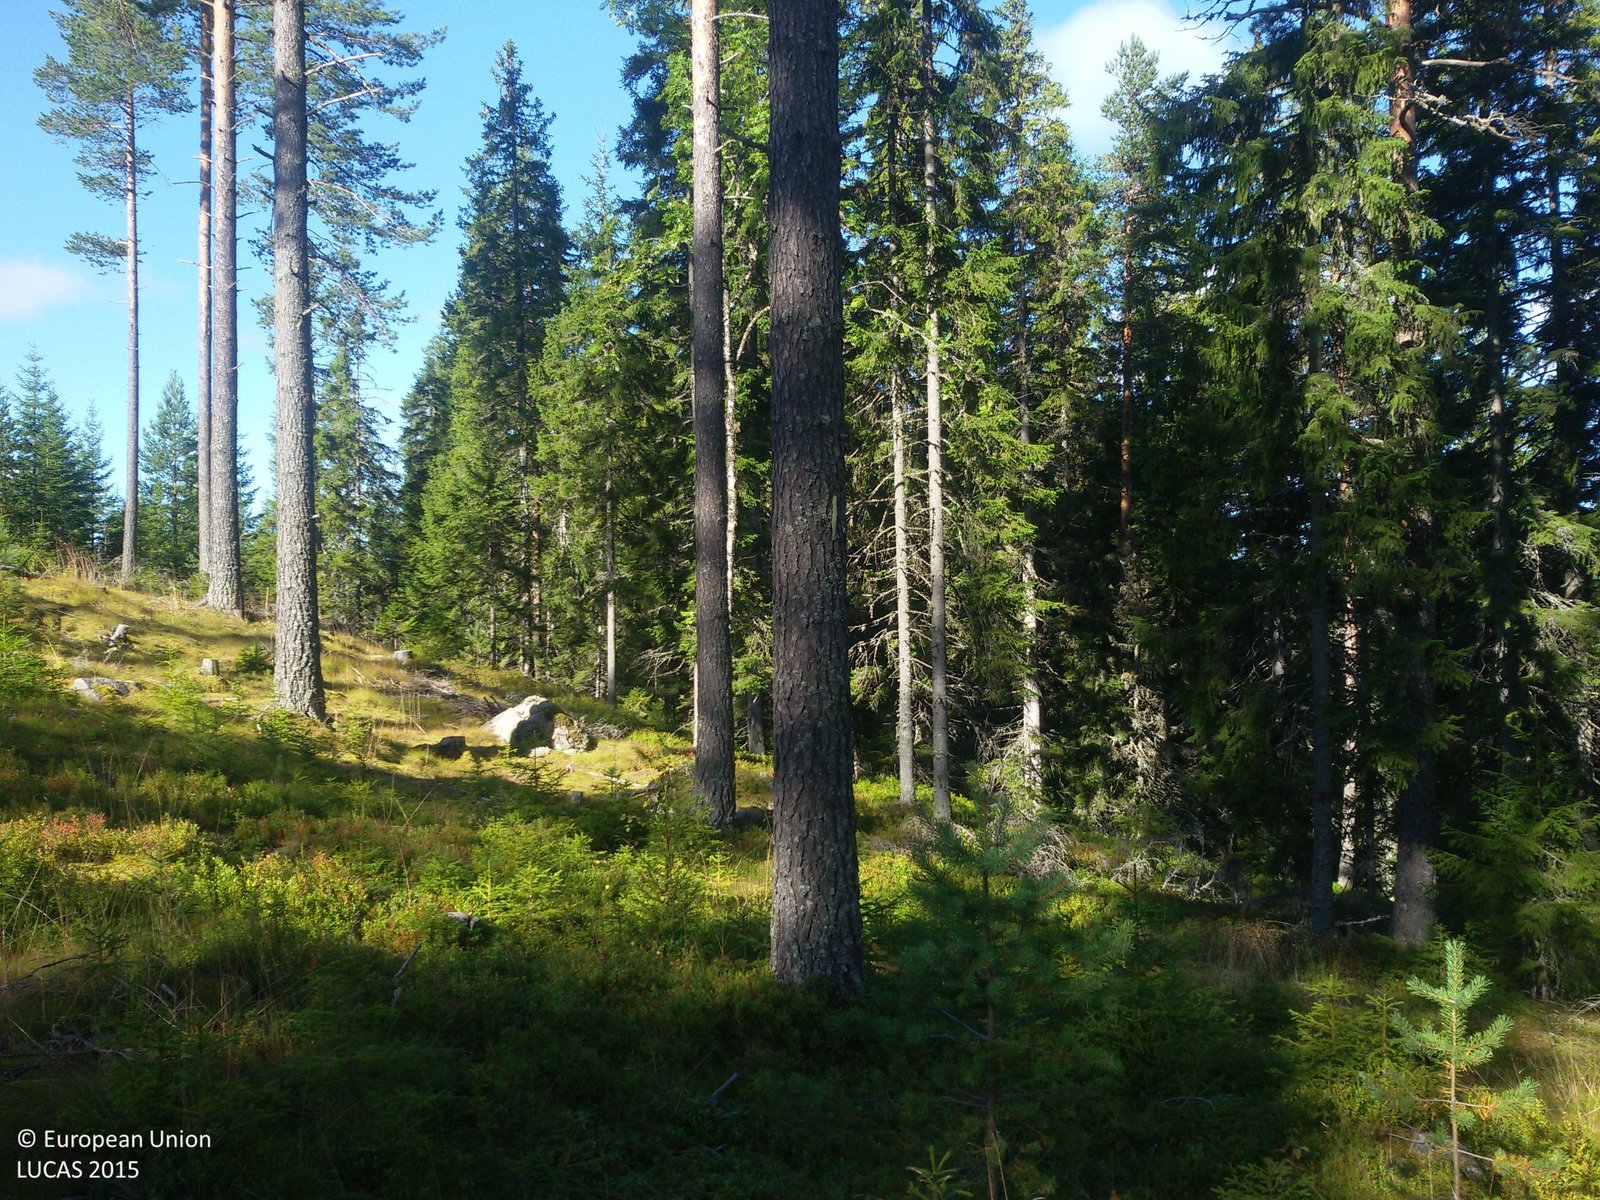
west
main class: Woodland
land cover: Pine dominated coniferous woodland
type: boreal forest
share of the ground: 25 - 50 %
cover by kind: shrubs 50 %, coniferous forest trees 40 %, lichens and mosses 10 %
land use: Forestry
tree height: > 5 m
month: September
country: SE
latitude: 60.8736
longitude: 15.3460
